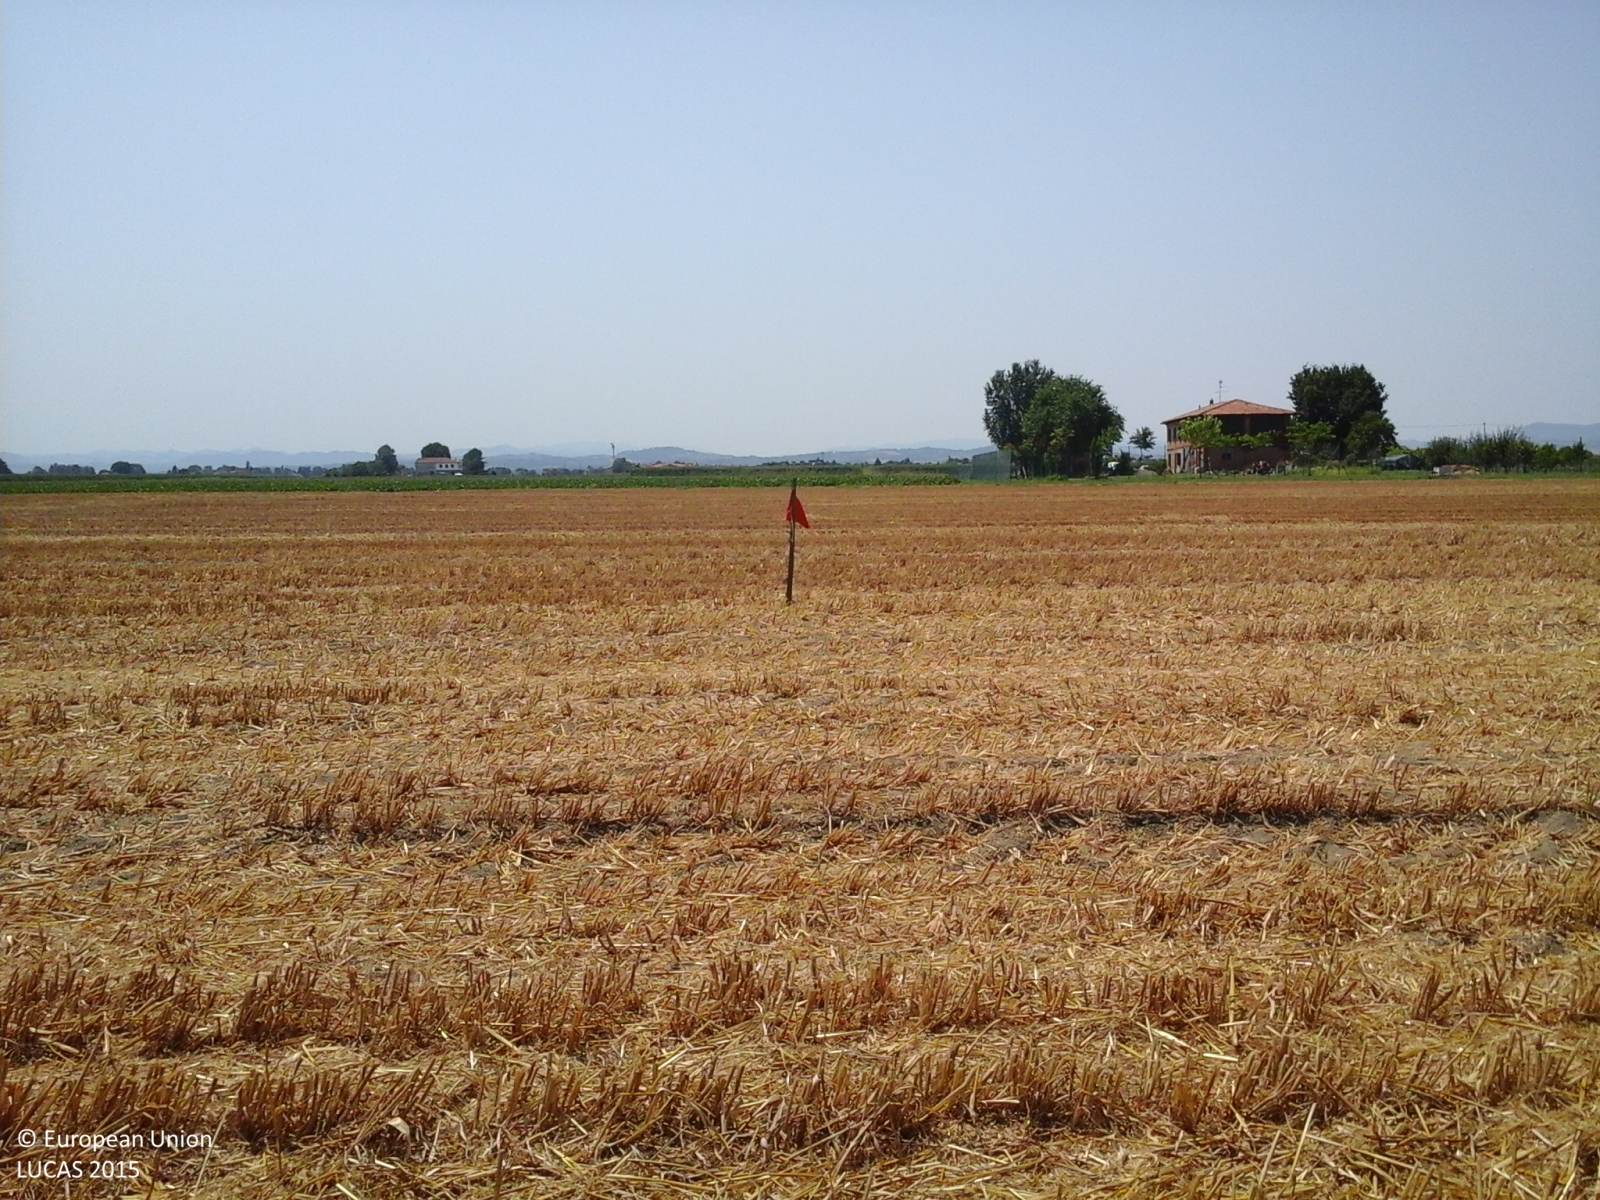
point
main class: Cropland
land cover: Common wheat
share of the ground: > 75 %
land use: Agriculture (excluding fallow land and kitchen gardens)
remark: Harvested field
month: July
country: IT
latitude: 44.4450
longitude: 11.6926
